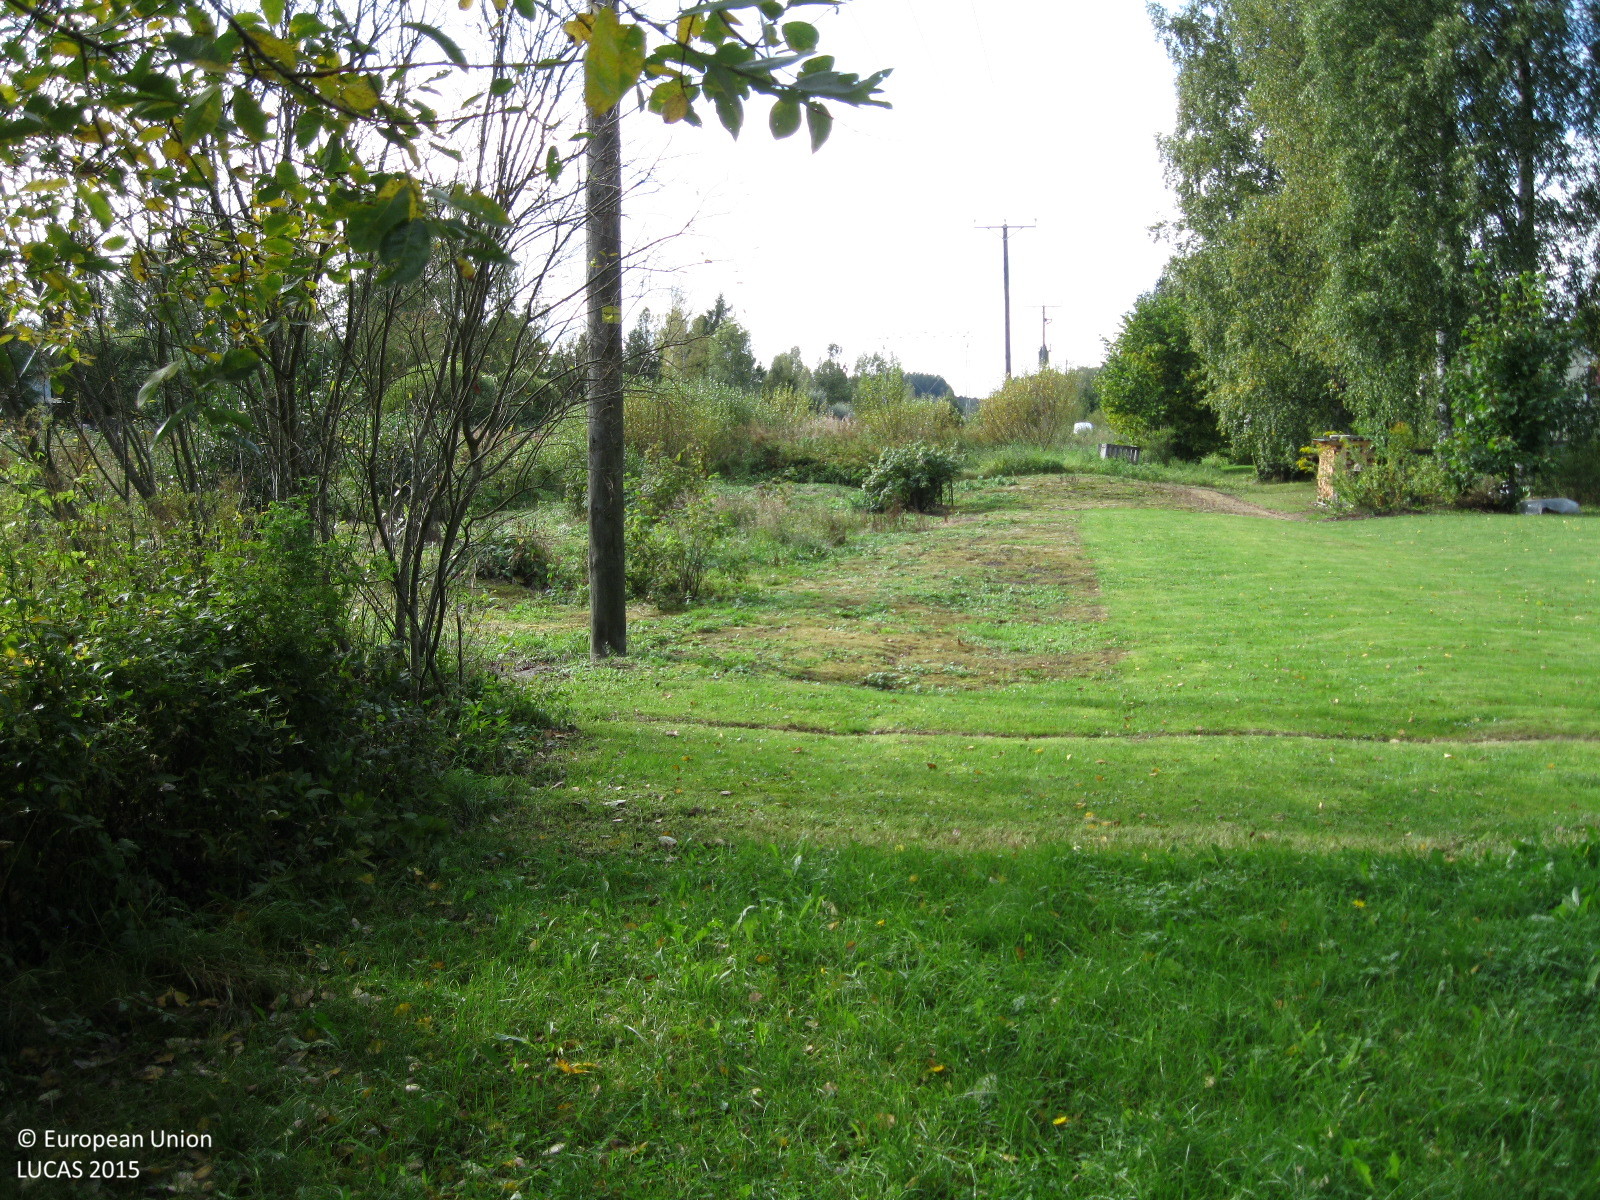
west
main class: Woodland
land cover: Broadleaved woodland
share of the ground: > 75 %
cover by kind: broadleaved forest trees 100 %
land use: Residential
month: September
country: FI
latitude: 60.7560
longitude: 24.7722
